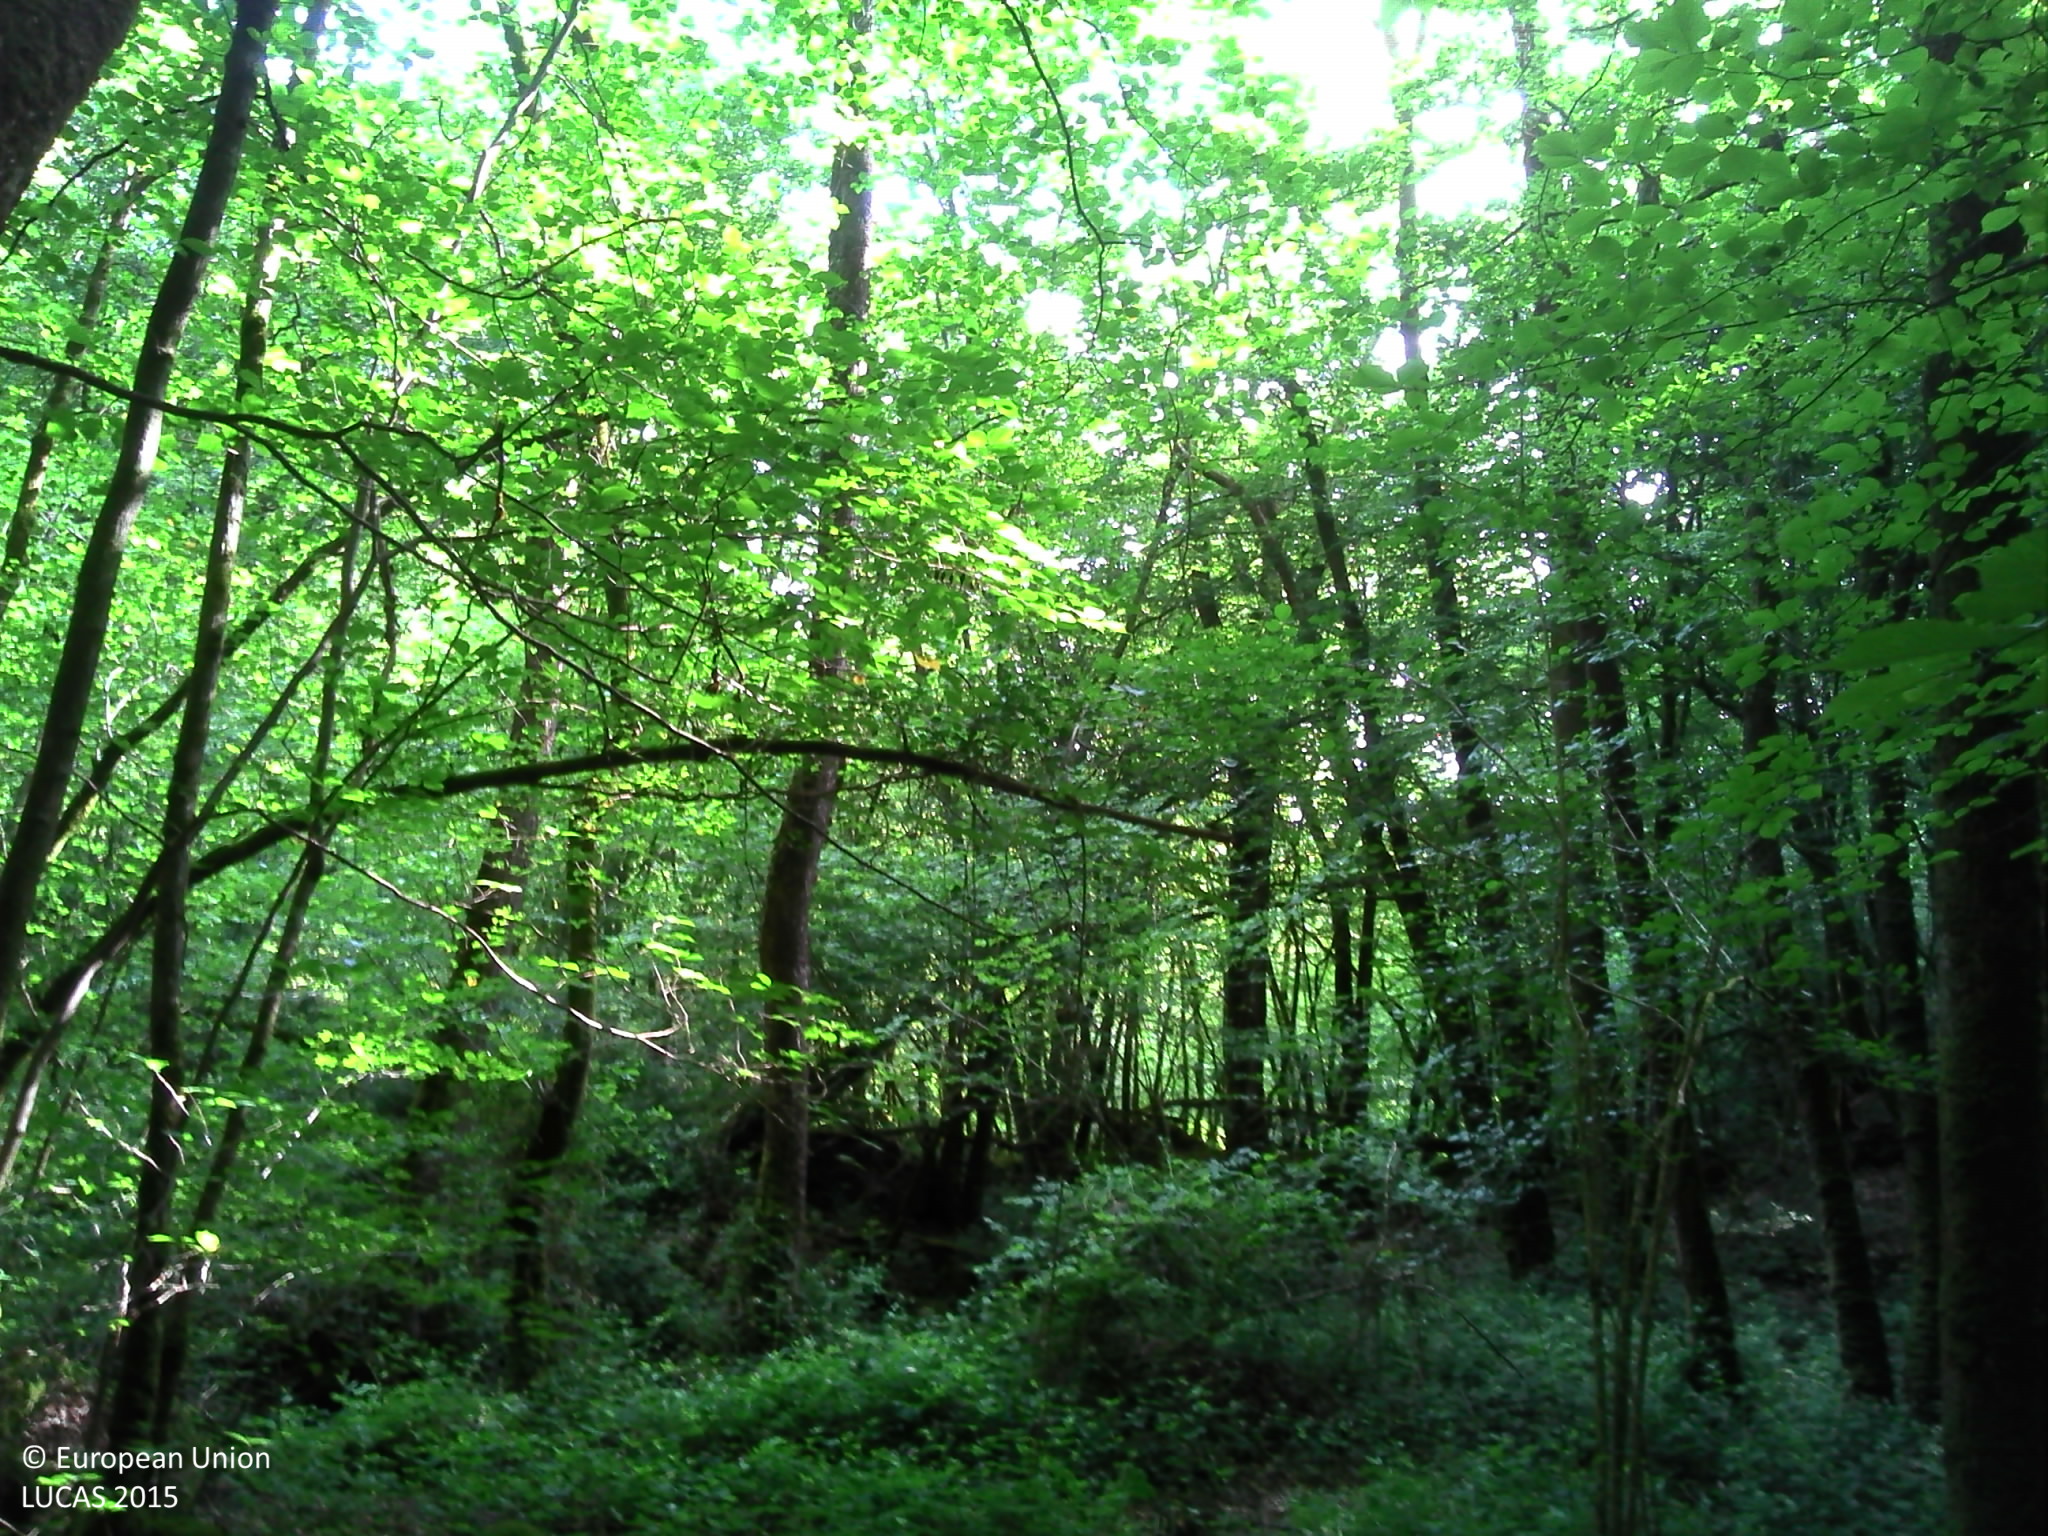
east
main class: Woodland
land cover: Broadleaved woodland
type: mesophytic deciduous forest
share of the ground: > 75 %
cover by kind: broadleaved forest trees 90 %, lichens and mosses 10 %
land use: Forestry
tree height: > 5 m
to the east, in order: Broadleaved woodland
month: June
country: FR
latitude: 47.3325
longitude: 3.8973
